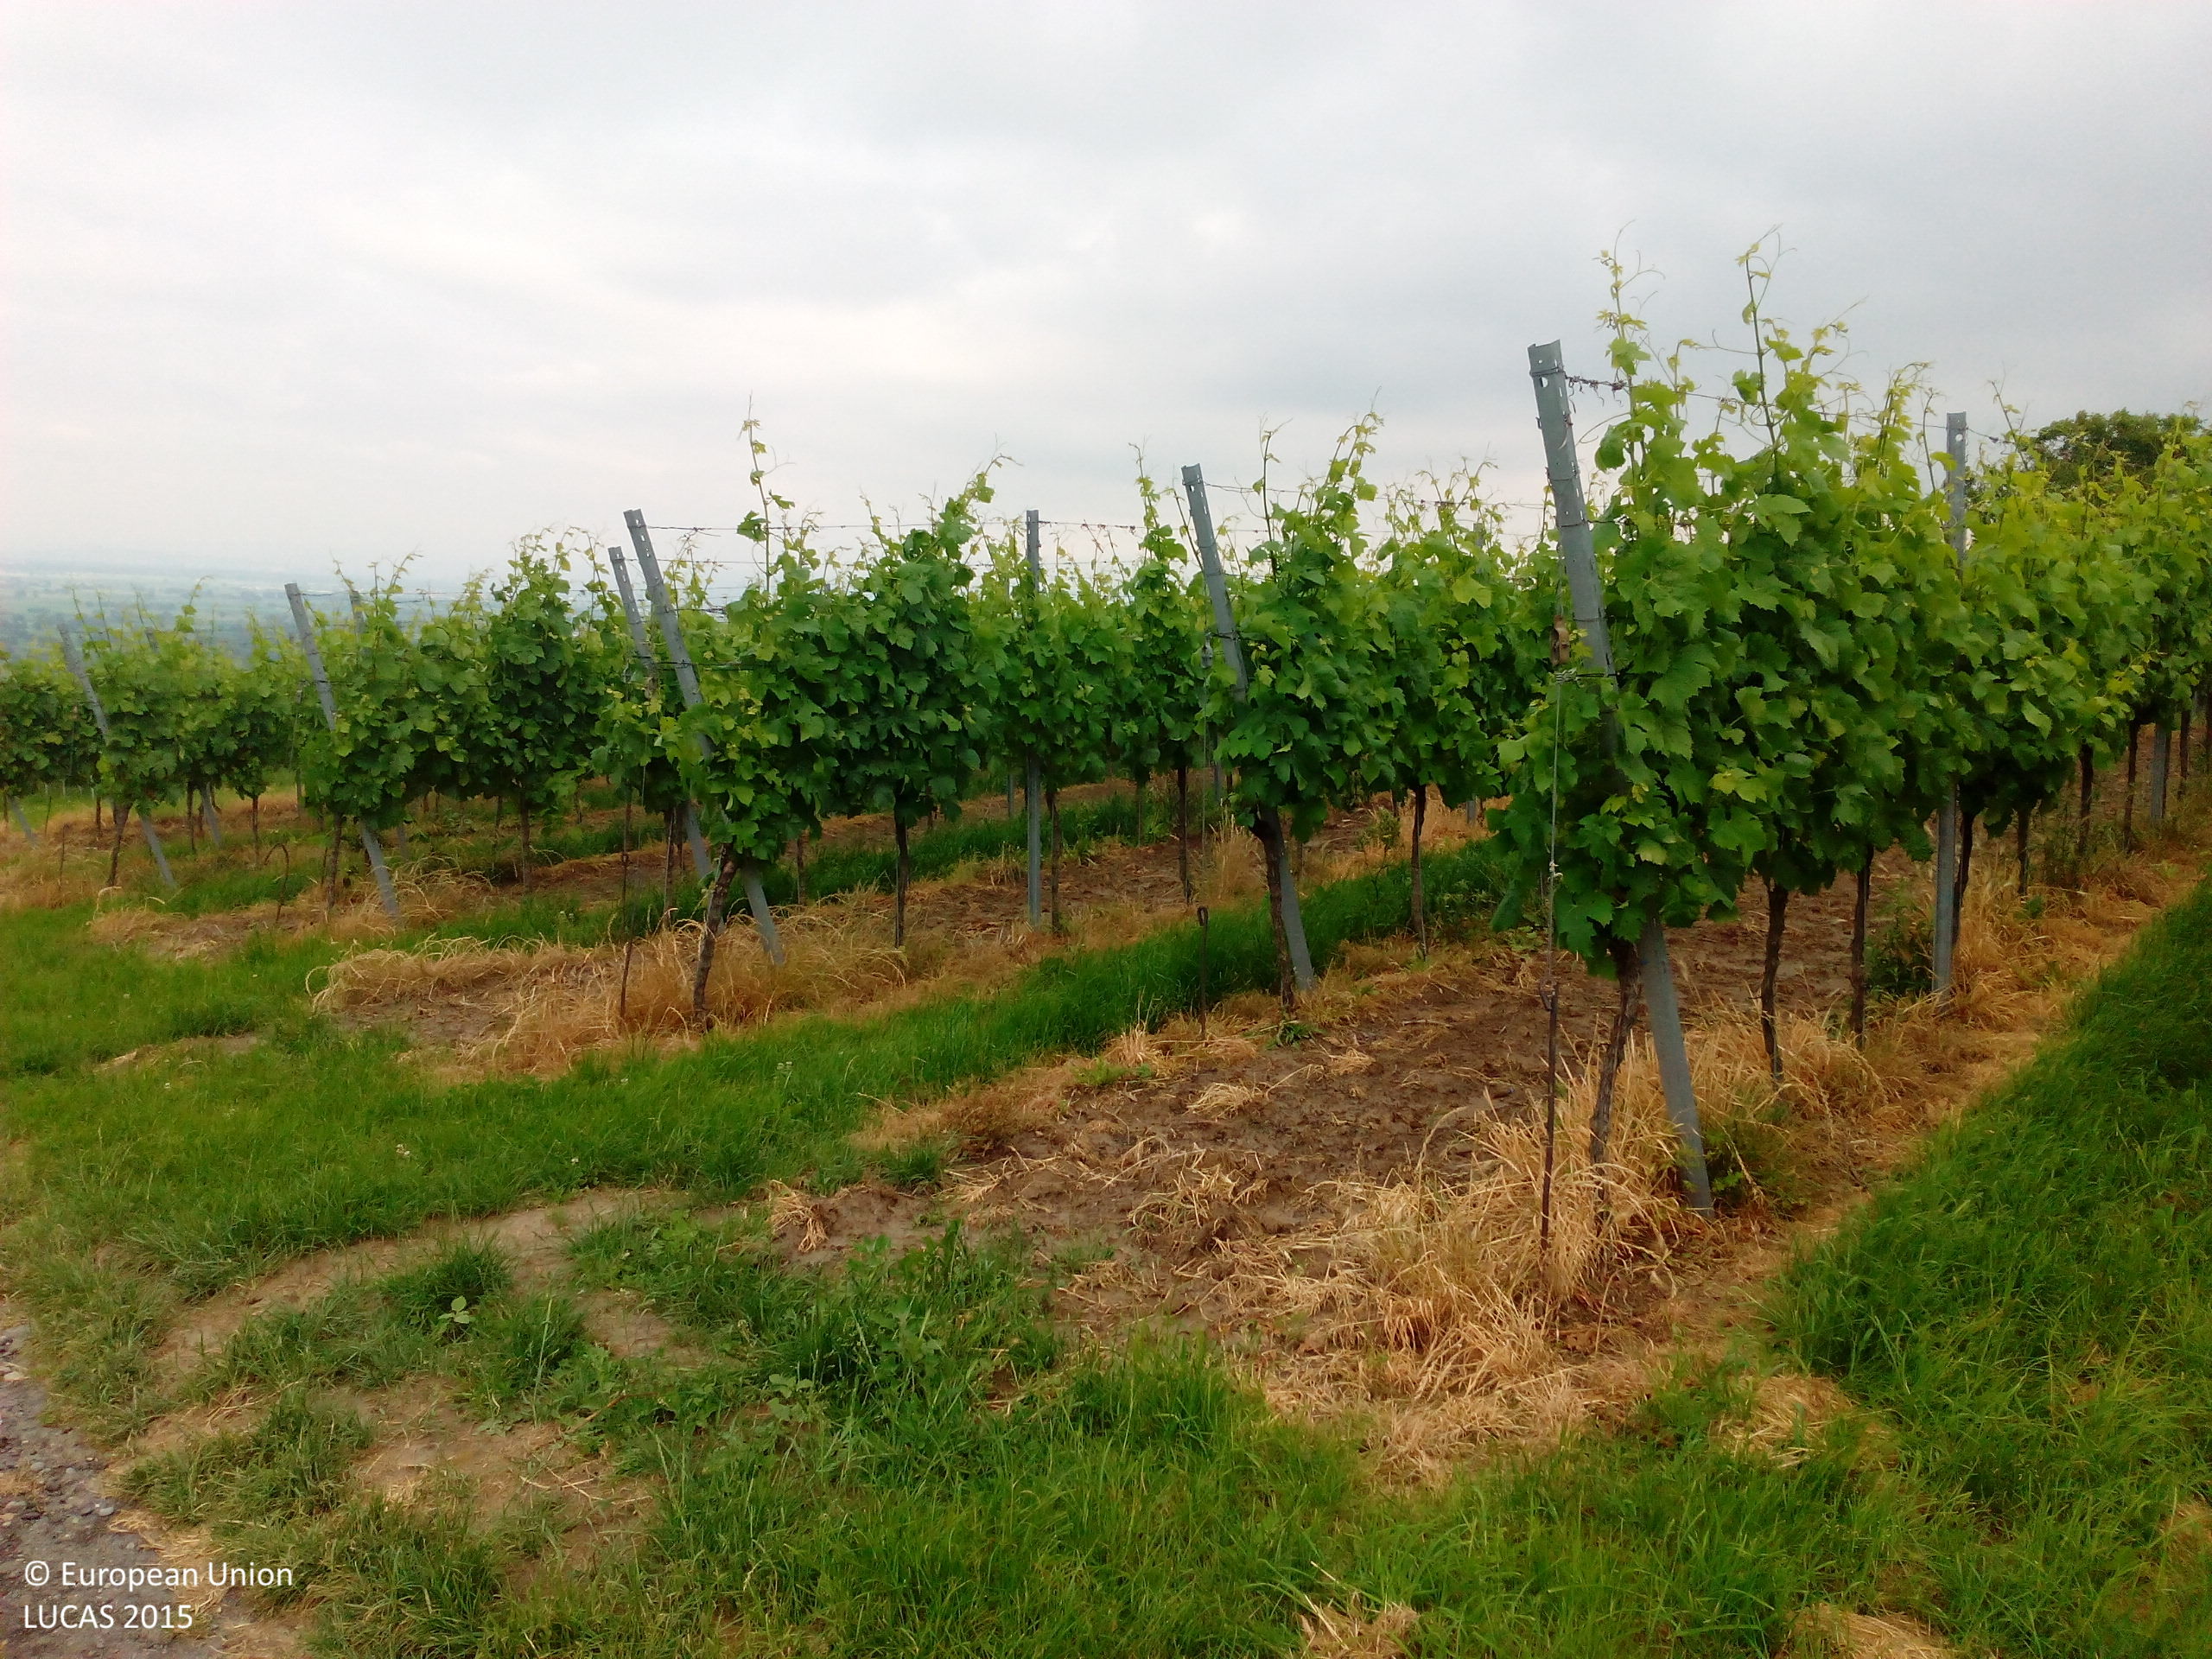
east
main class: Cropland
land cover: Vineyards
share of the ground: 25 - 50 %
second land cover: Grassland without tree/shrub cover
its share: 50 - 75 %
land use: Agriculture (excluding fallow land and kitchen gardens)
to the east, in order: Tracks; Grass margins; Vineyards; Grassland without tree/shrub cover; Broadleaved woodland; Tracks; Shrubland with sparse tree cover; Vineyards; Shrubland with sparse tree cover; Vineyards; Tracks; Vineyards; Electric lines; Vineyards; Shrubland with sparse tree cover; Vineyards
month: June
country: DE
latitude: 48.1259
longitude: 7.6231
